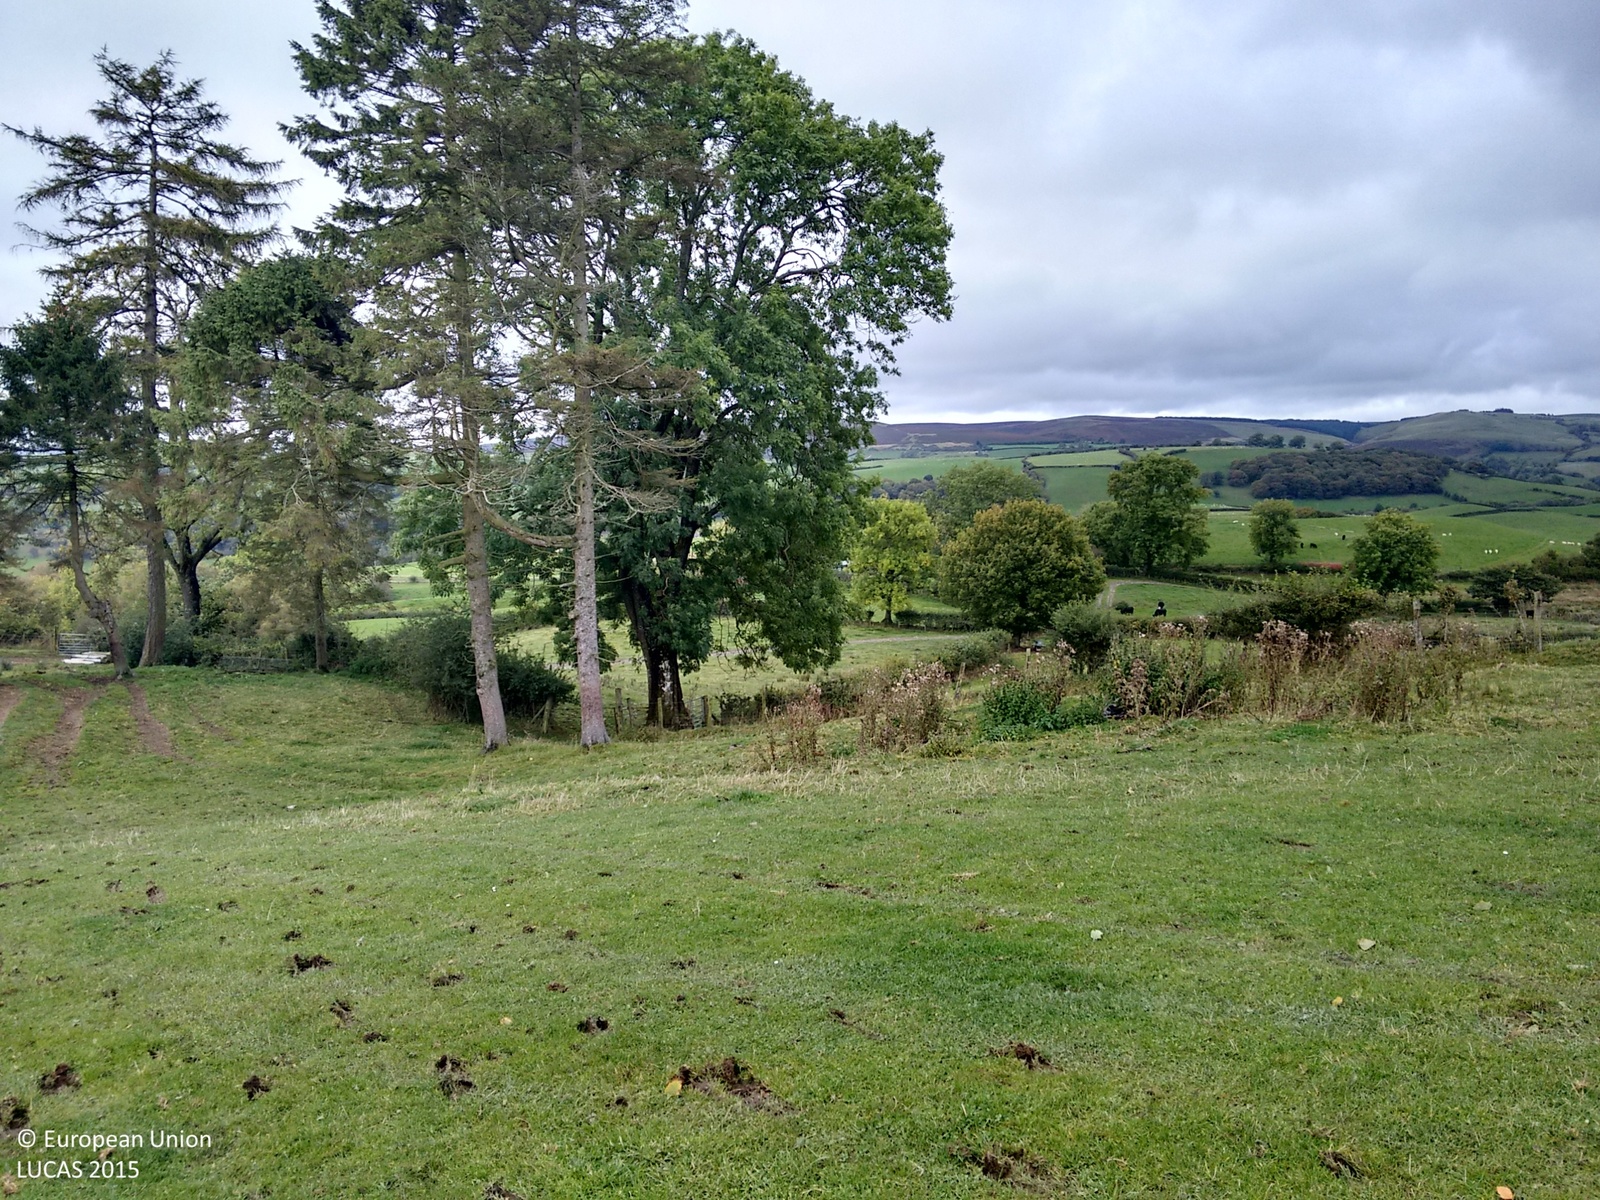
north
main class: Grassland
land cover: Grassland without tree/shrub cover
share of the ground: > 75 %
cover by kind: herbaceous plants 100 %
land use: Agriculture (excluding fallow land and kitchen gardens)
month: October
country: GB
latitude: 52.3275
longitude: -3.2116
